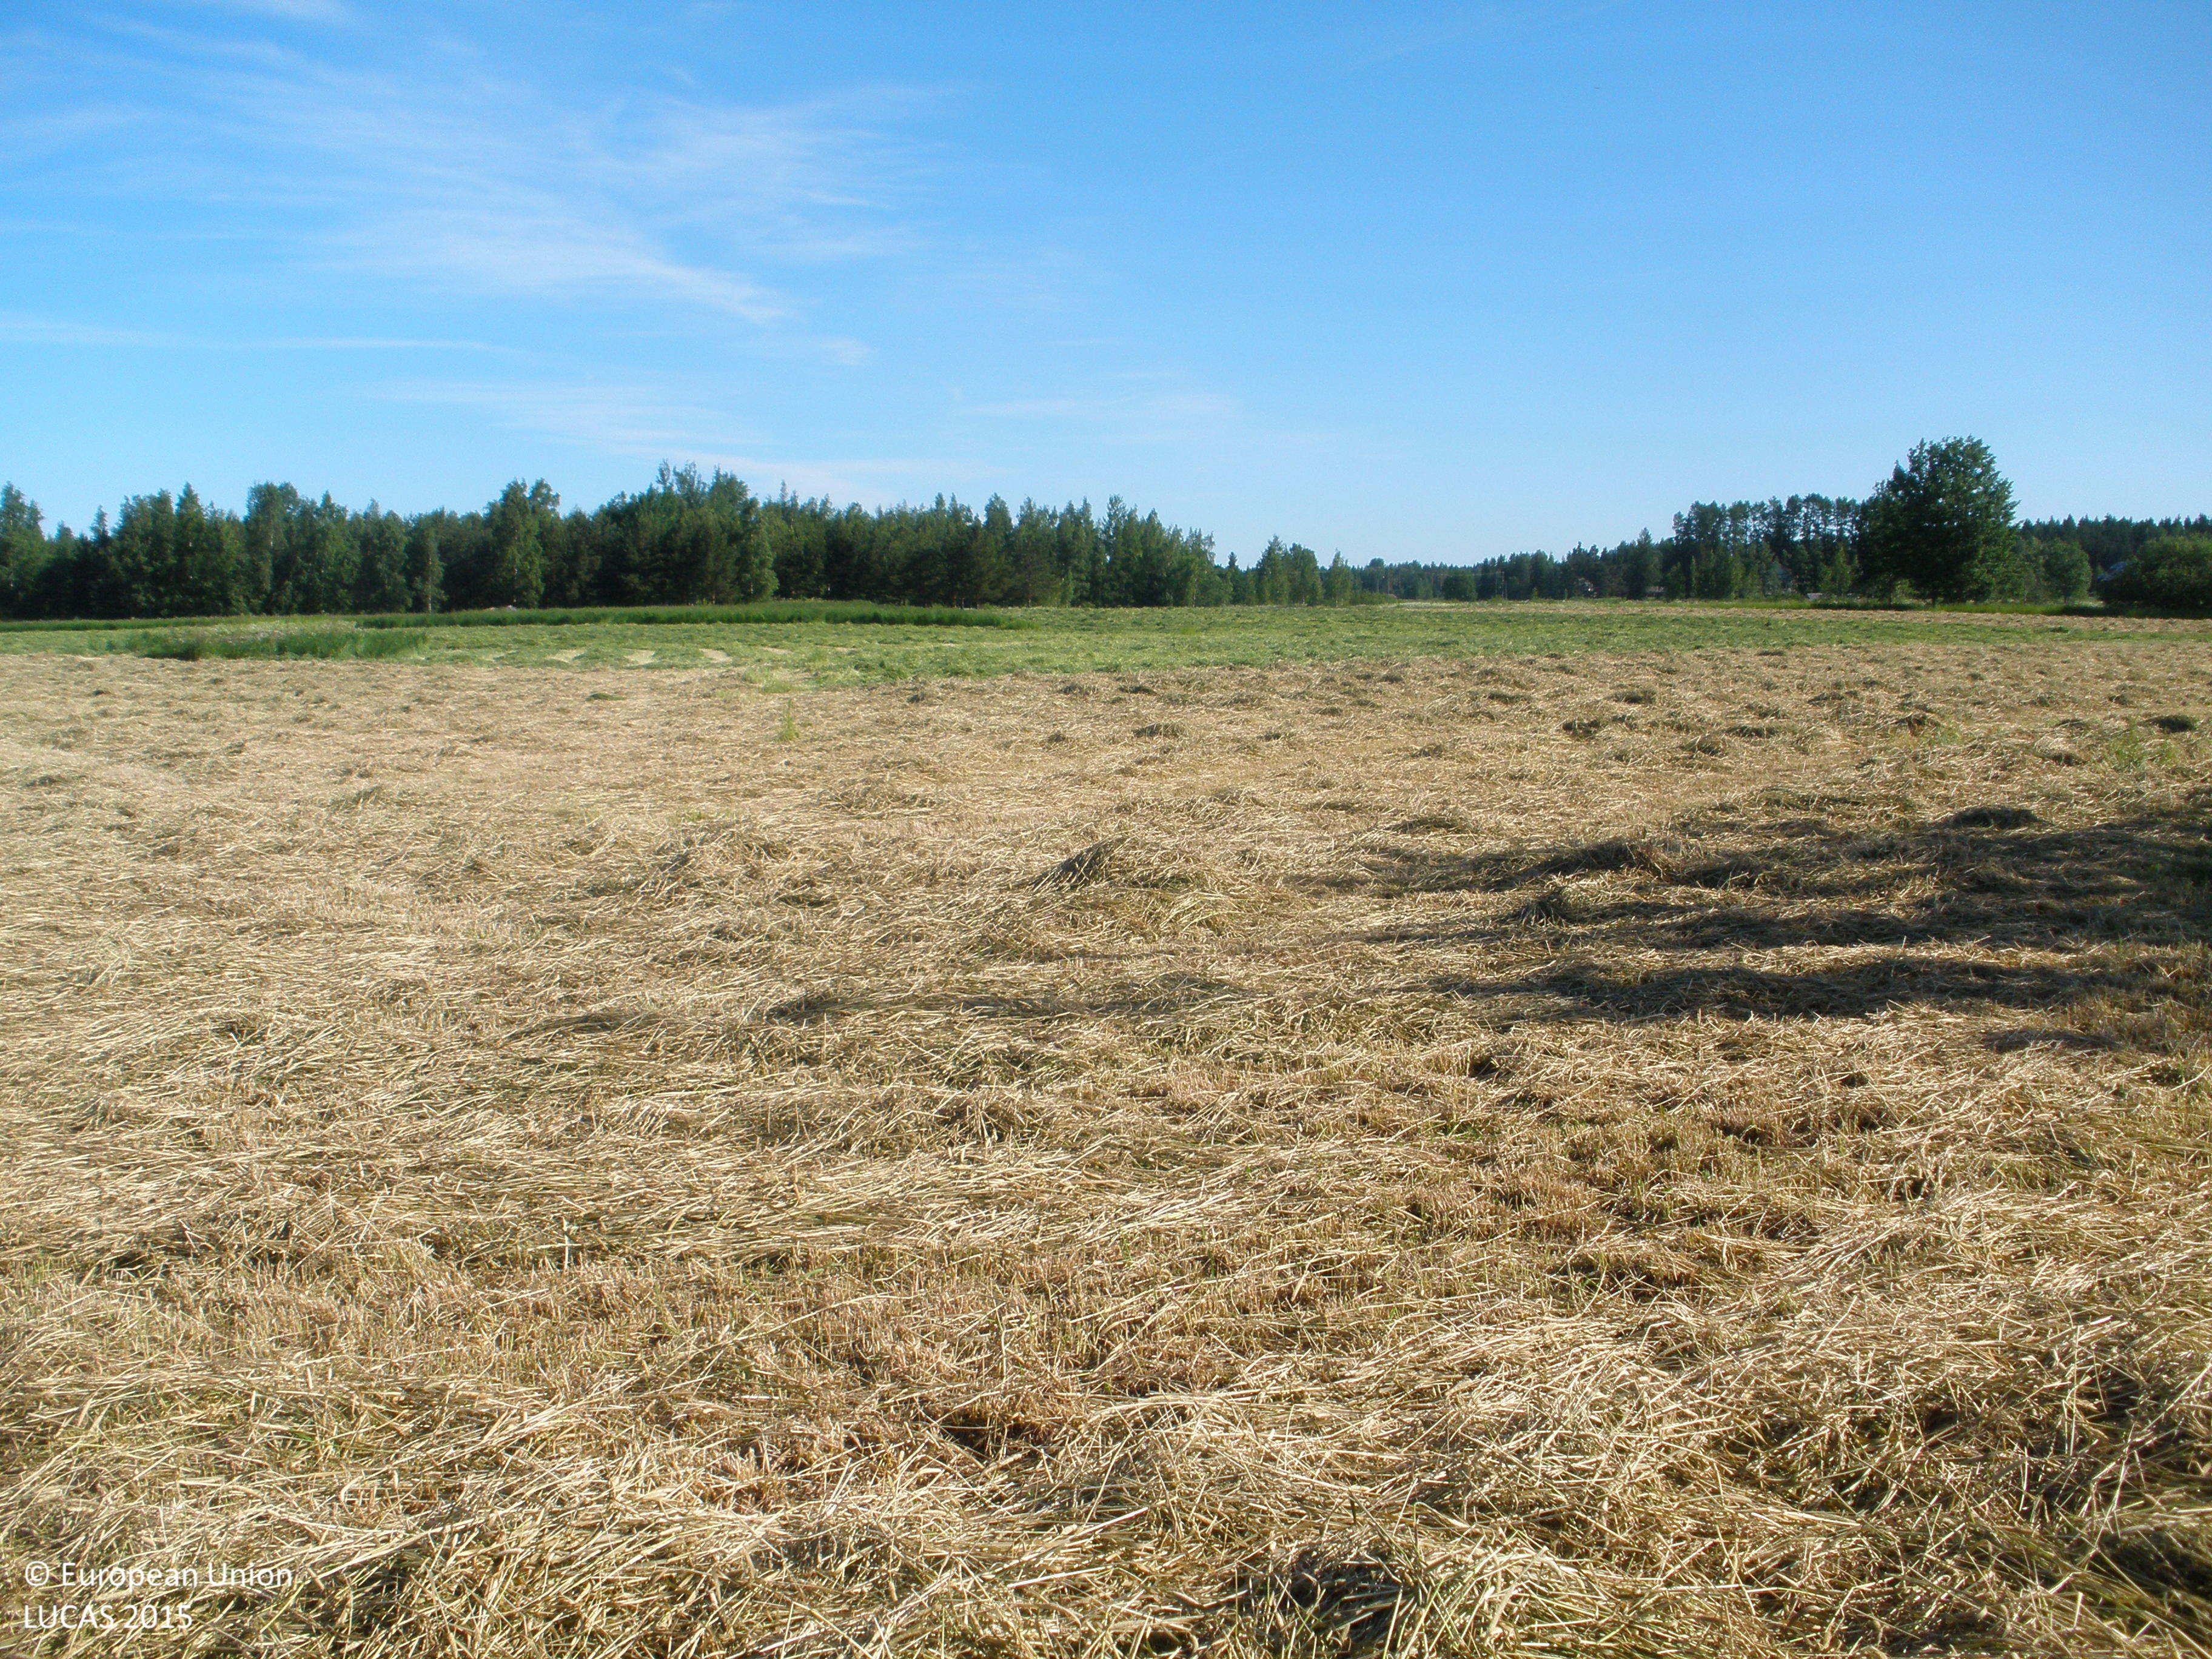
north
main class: Cropland
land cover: Mixed cereals for fodder
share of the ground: 25 - 50 %
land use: Agriculture (excluding fallow land and kitchen gardens)
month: July
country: FI
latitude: 61.2302
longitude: 23.8903
